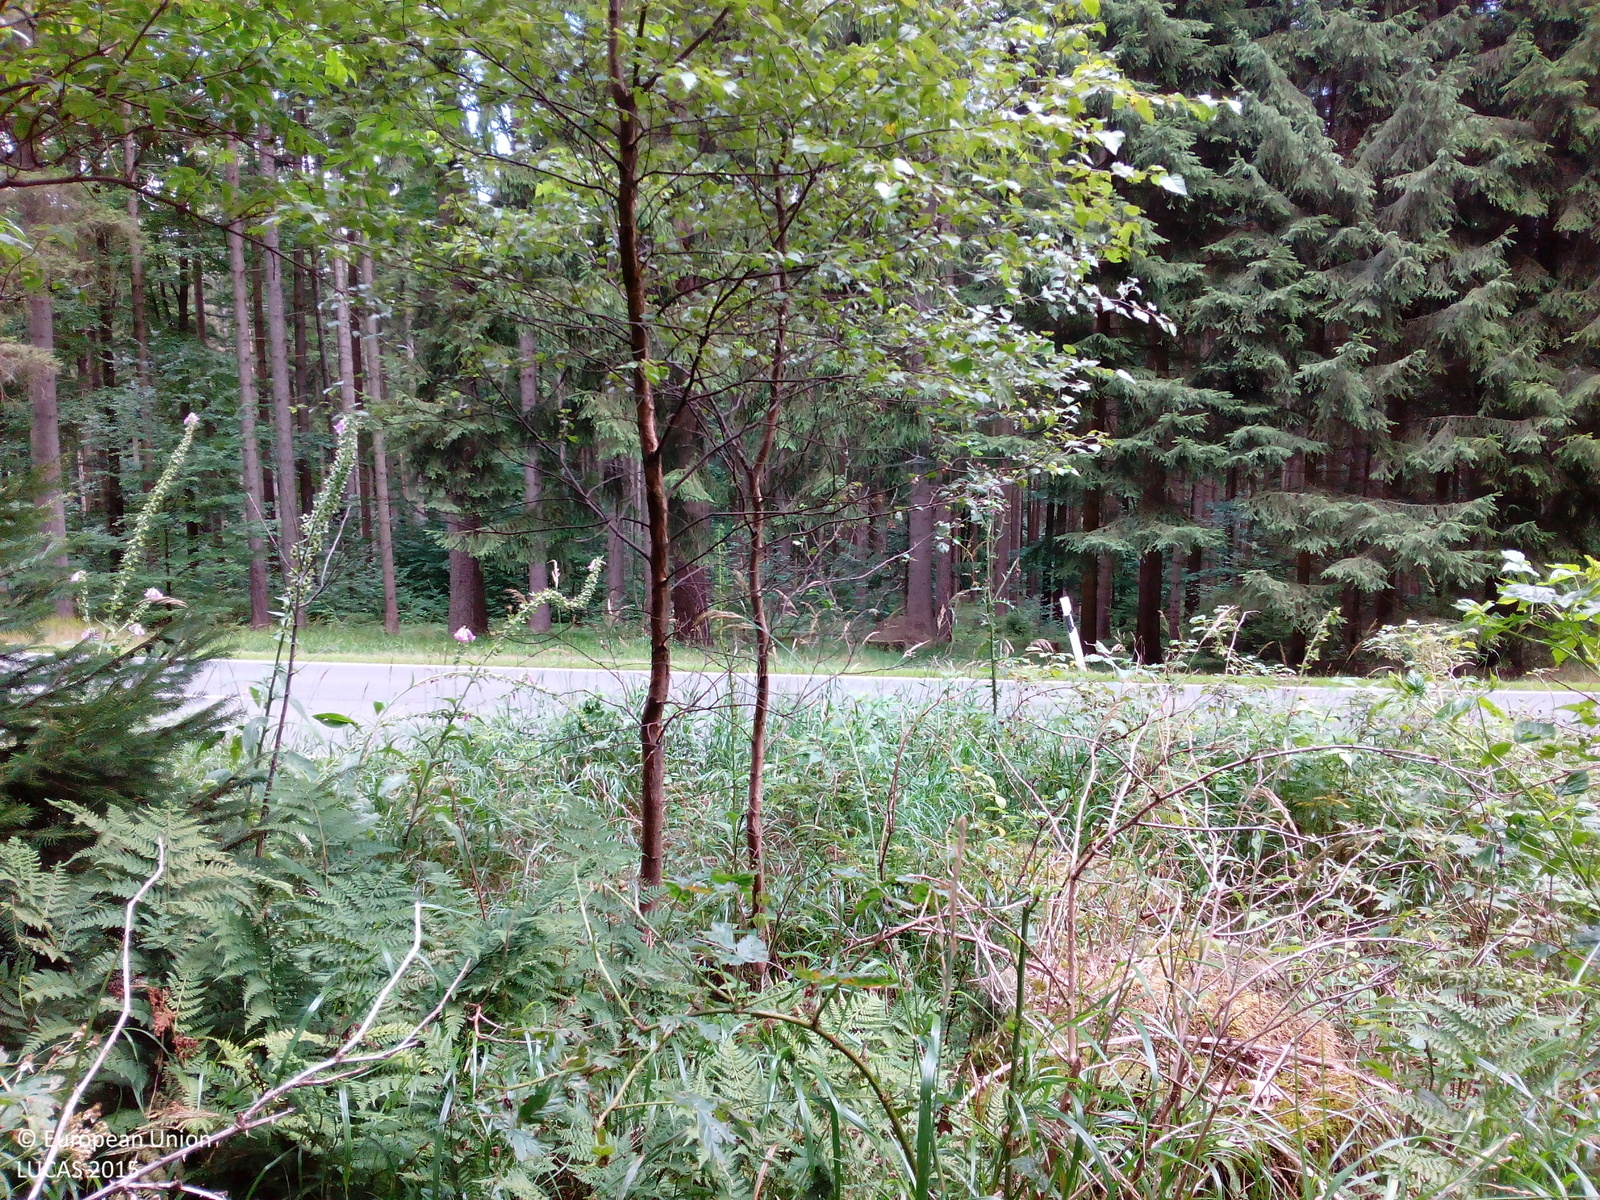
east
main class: Woodland
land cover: Spruce dominated mixed woodland
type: hemiboreal forest and nemoral coniferous forest and mixed broadleaved-coniferous forest
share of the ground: > 75 %
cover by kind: coniferous forest trees 50 %, broadleaved forest trees 25 %, herbaceous plants 15 %, shrubs 10 %
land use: Forestry
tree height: < 5 m
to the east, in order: Spruce dominated mixed woodland; Grass margins; Ditches and canals; Paved roads, cycling and walking lanes; Grass margins; Spruce dominated mixed woodland; Tracks; Spruce dominated mixed woodland; Tracks; Grass margins; Spruce dominated mixed woodland; Tracks; Spruce dominated mixed woodland
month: July
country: DE
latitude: 49.7817
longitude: 12.3745
